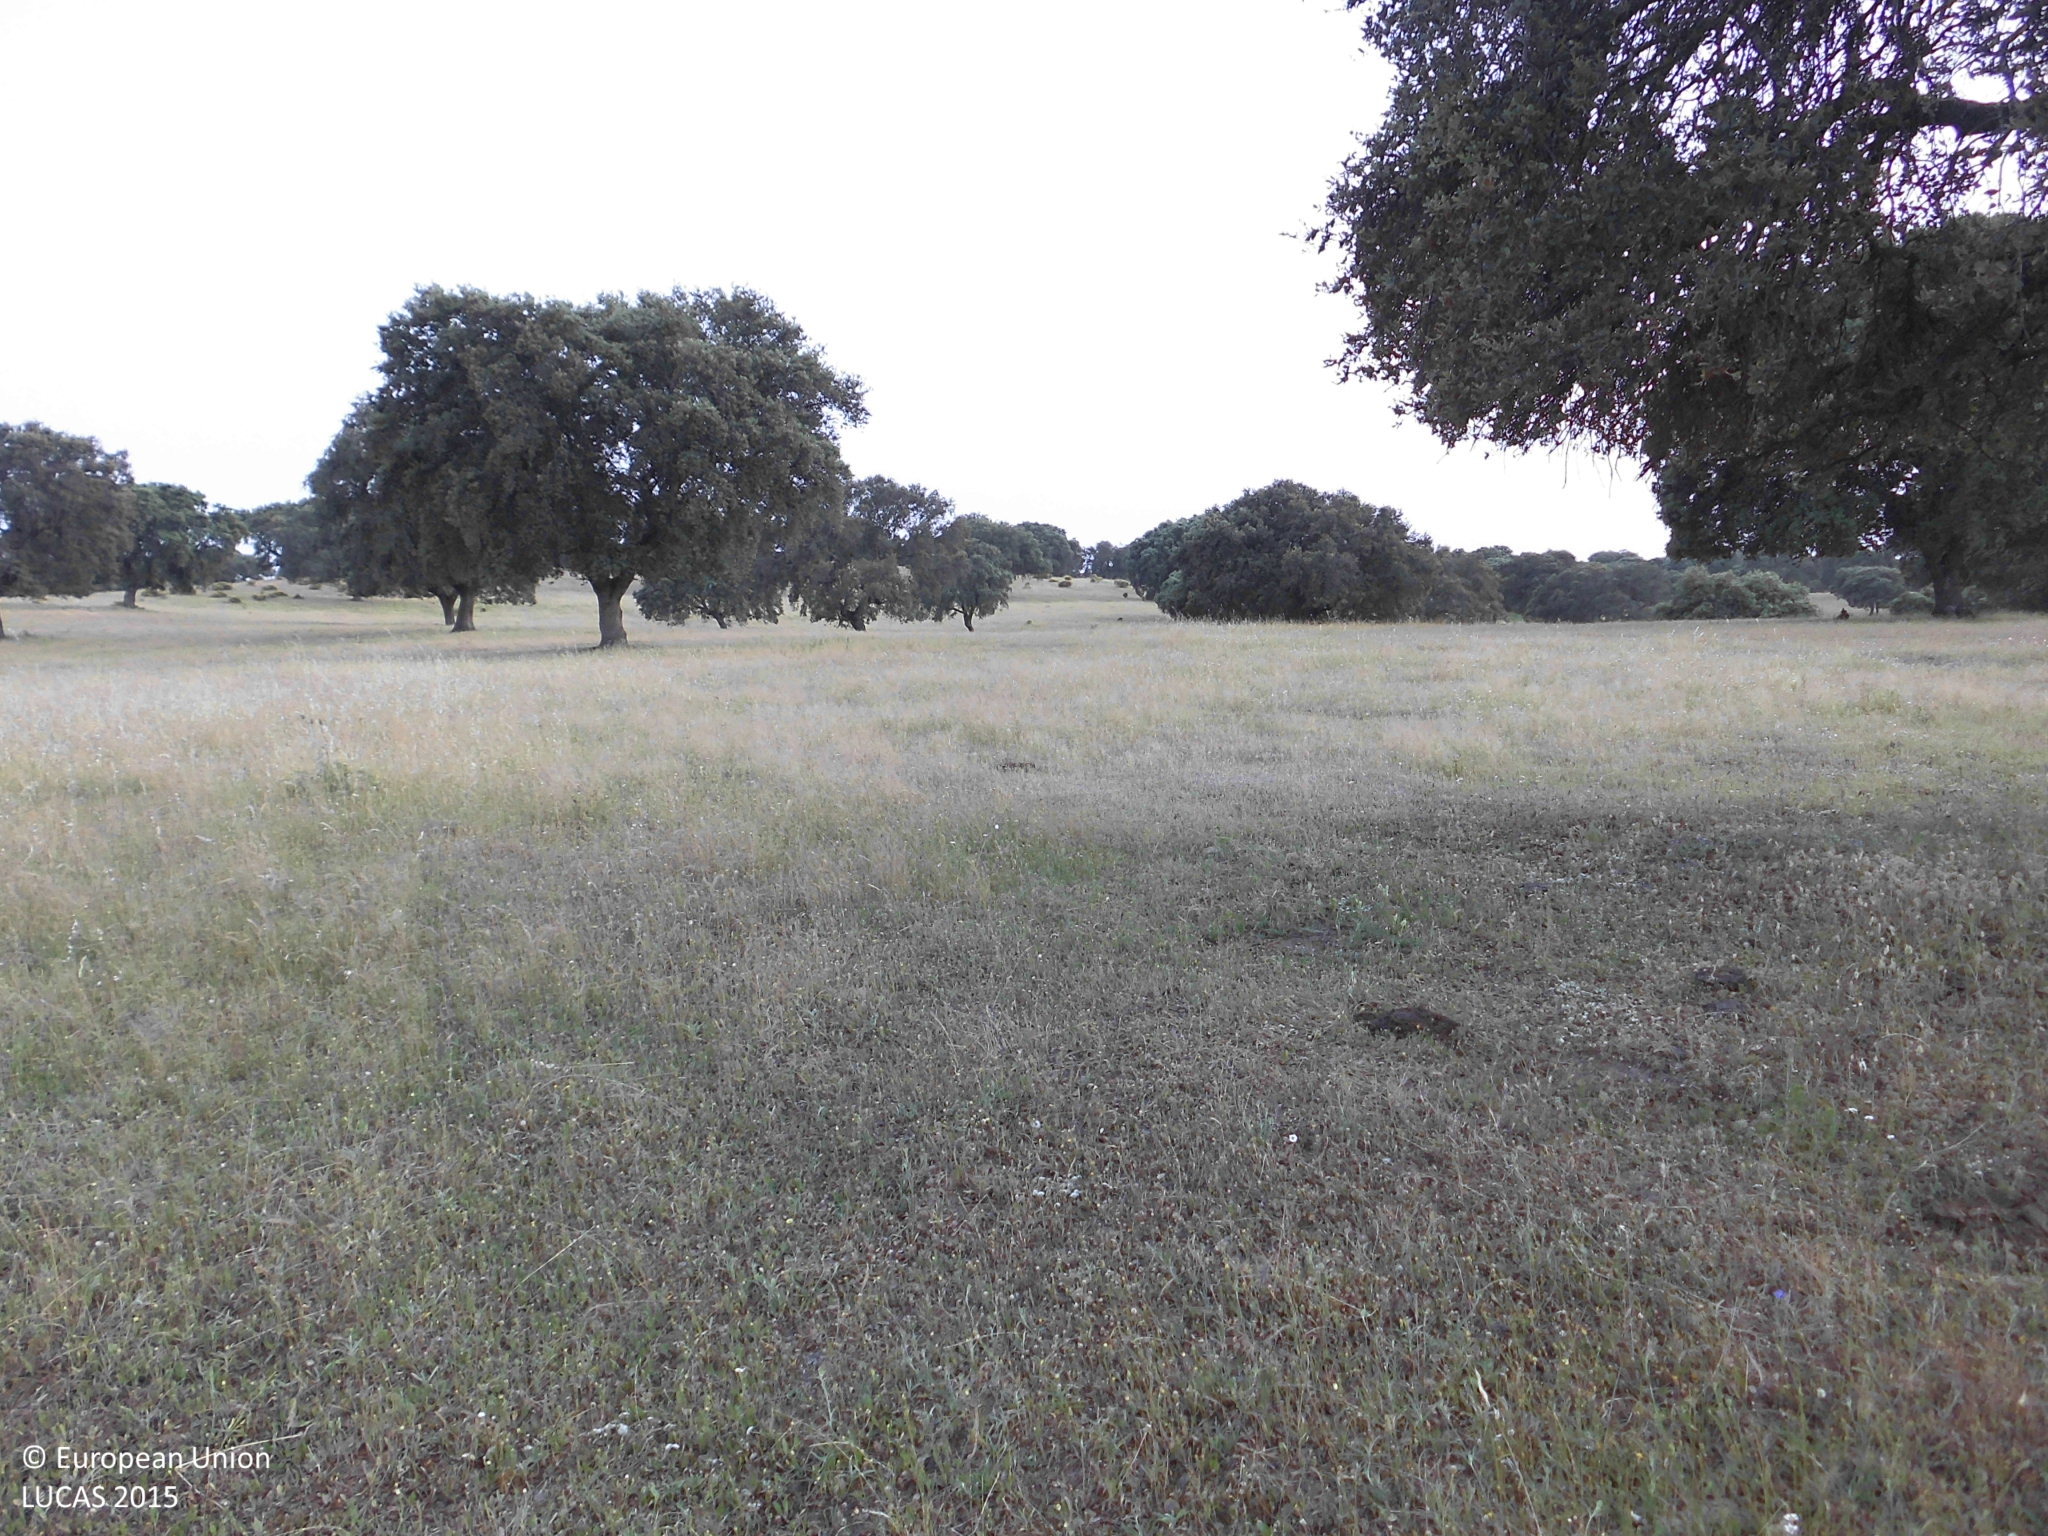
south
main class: Woodland
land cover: Broadleaved woodland
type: broadleaved evergreen forest
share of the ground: 10 - 25 %
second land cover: Grassland without tree/shrub cover
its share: > 75 %
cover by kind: herbaceous plants 85 %, broadleaved forest trees 15 %
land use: Forestry
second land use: Agriculture (excluding fallow land and kitchen gardens)
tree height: > 5 m
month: May
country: ES
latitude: 39.6790
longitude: -6.1207
